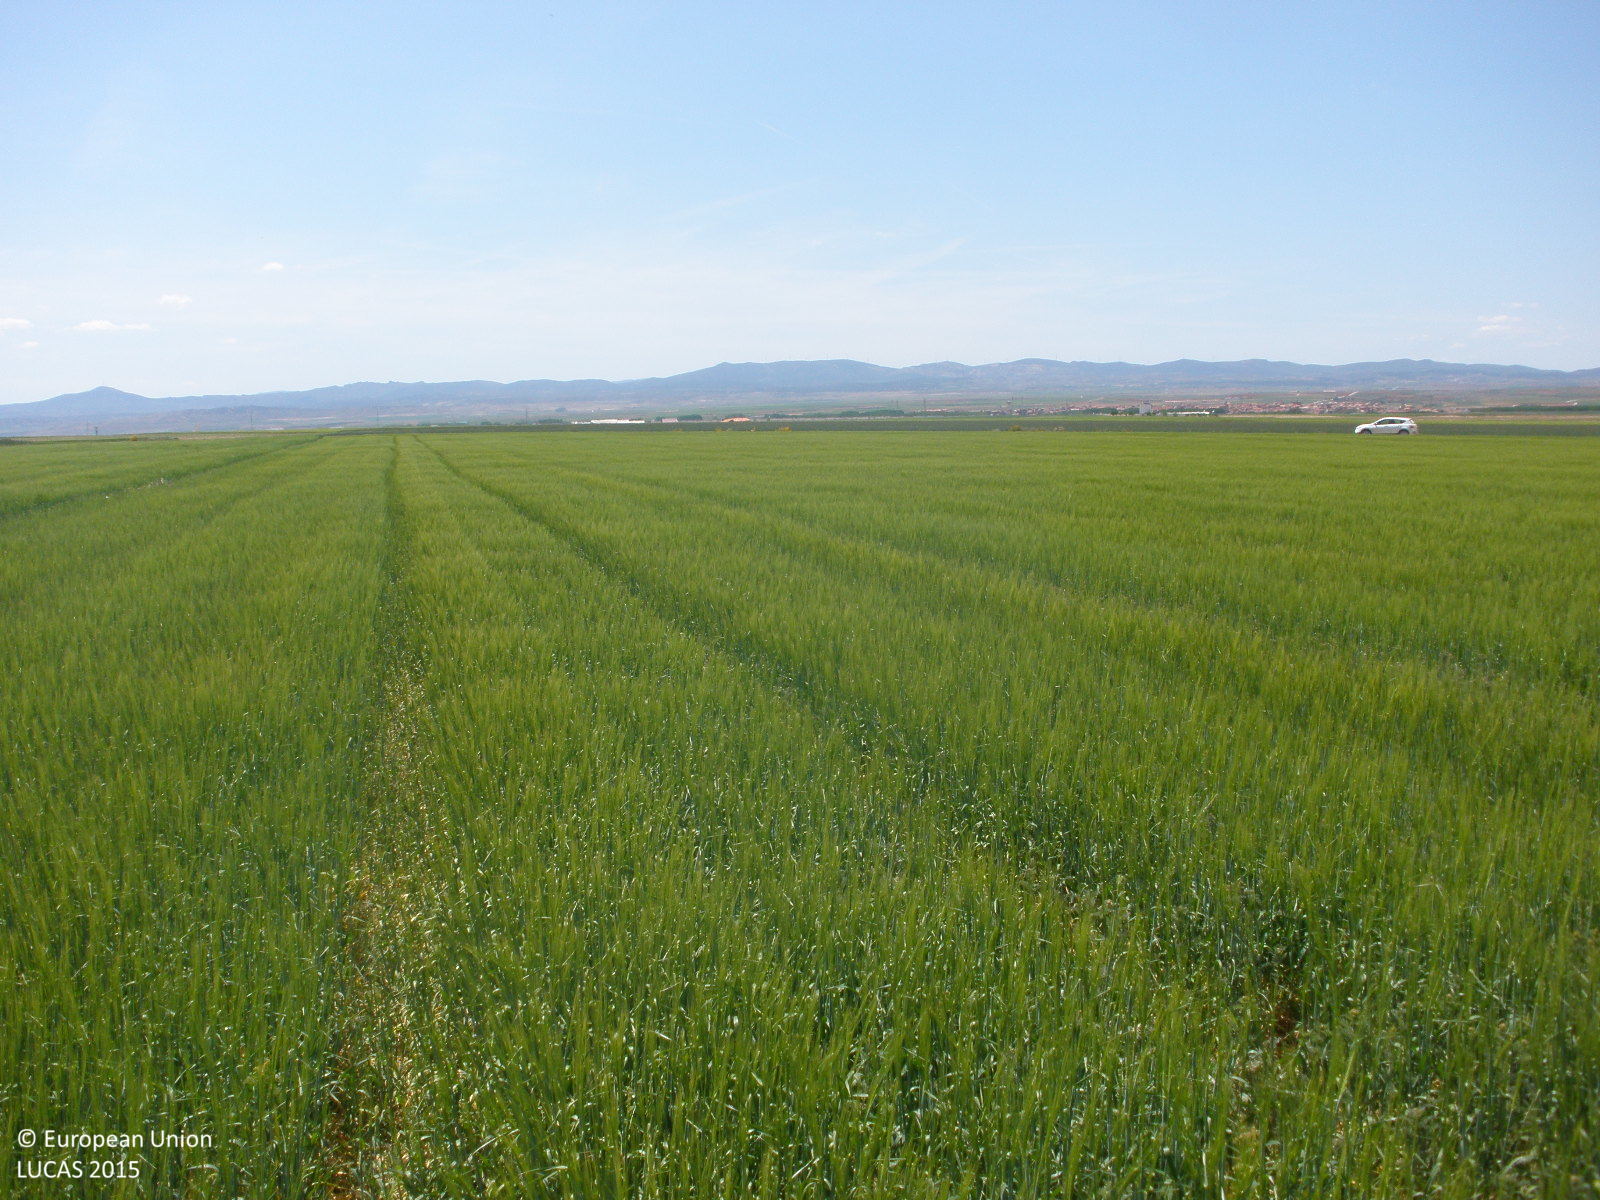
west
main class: Cropland
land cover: Barley
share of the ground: > 75 %
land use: Agriculture (excluding fallow land and kitchen gardens)
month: May
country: ES
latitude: 40.7969
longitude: -1.3120
